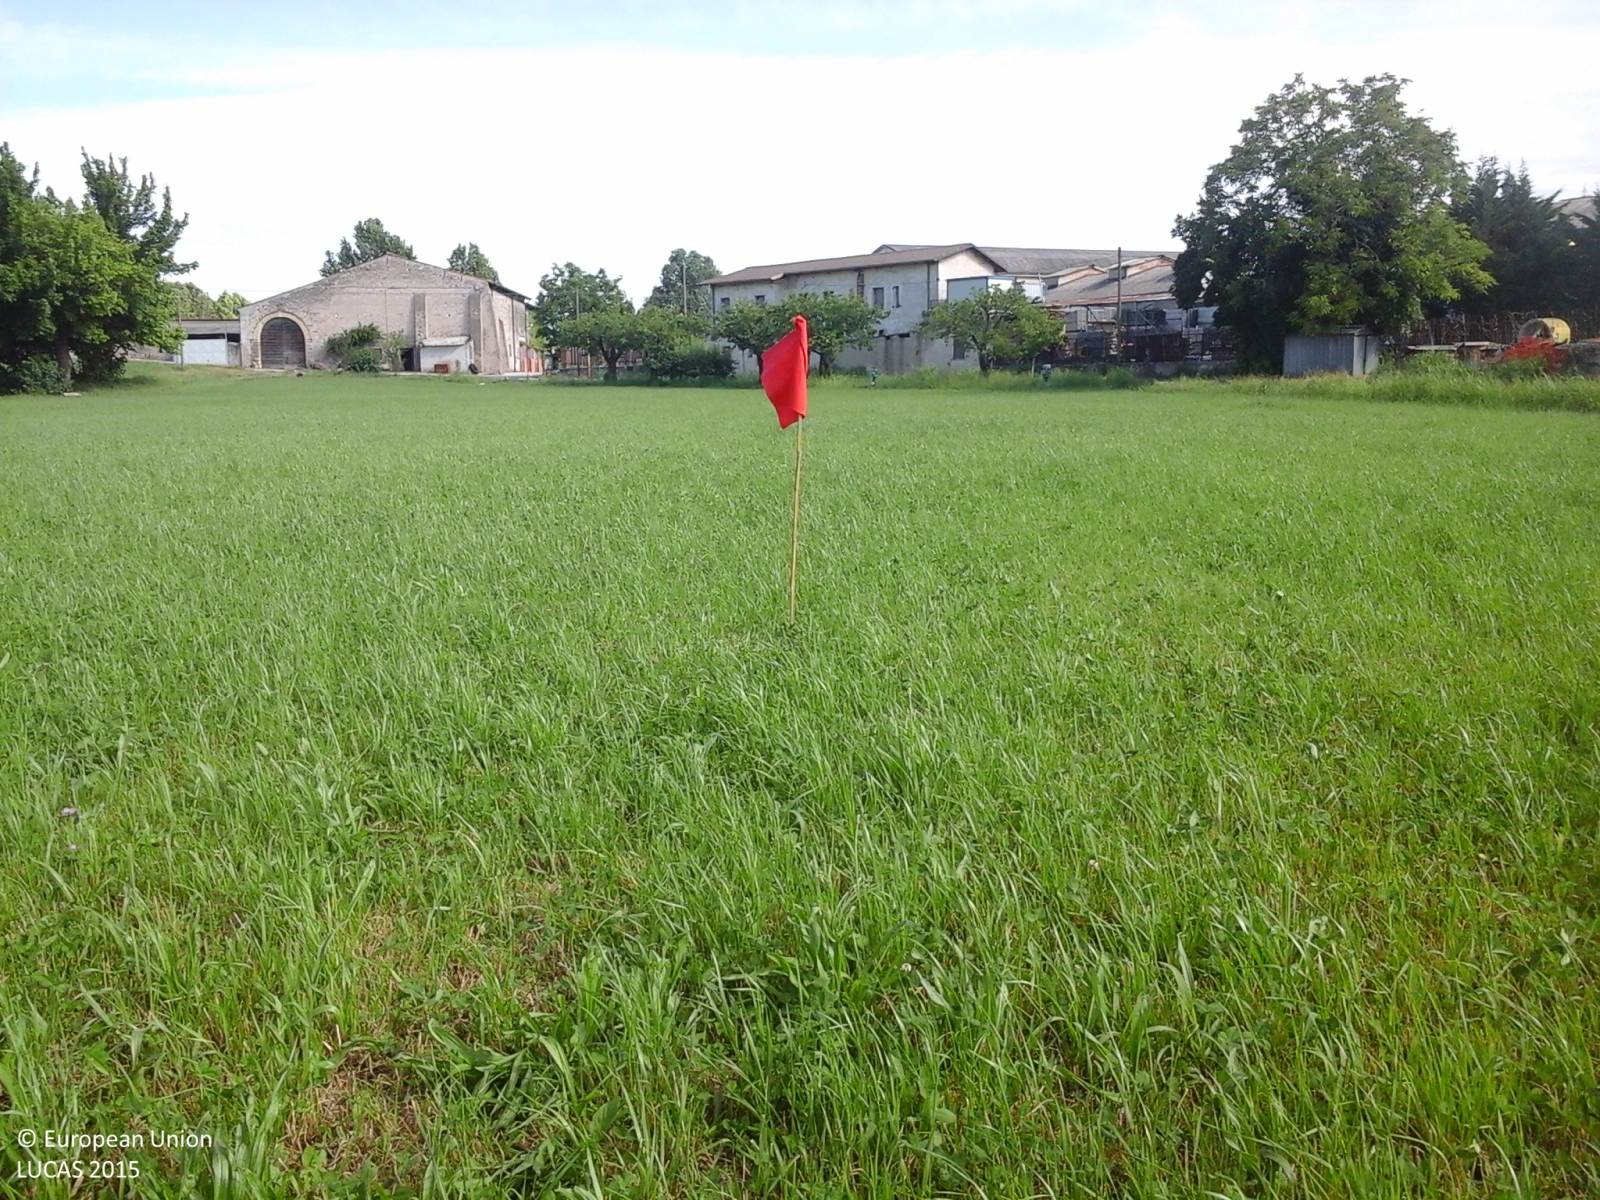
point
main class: Grassland
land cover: Grassland without tree/shrub cover
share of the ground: > 75 %
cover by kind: herbaceous plants 100 %
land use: Agriculture (excluding fallow land and kitchen gardens)
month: June
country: IT
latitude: 45.4085
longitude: 11.1097
